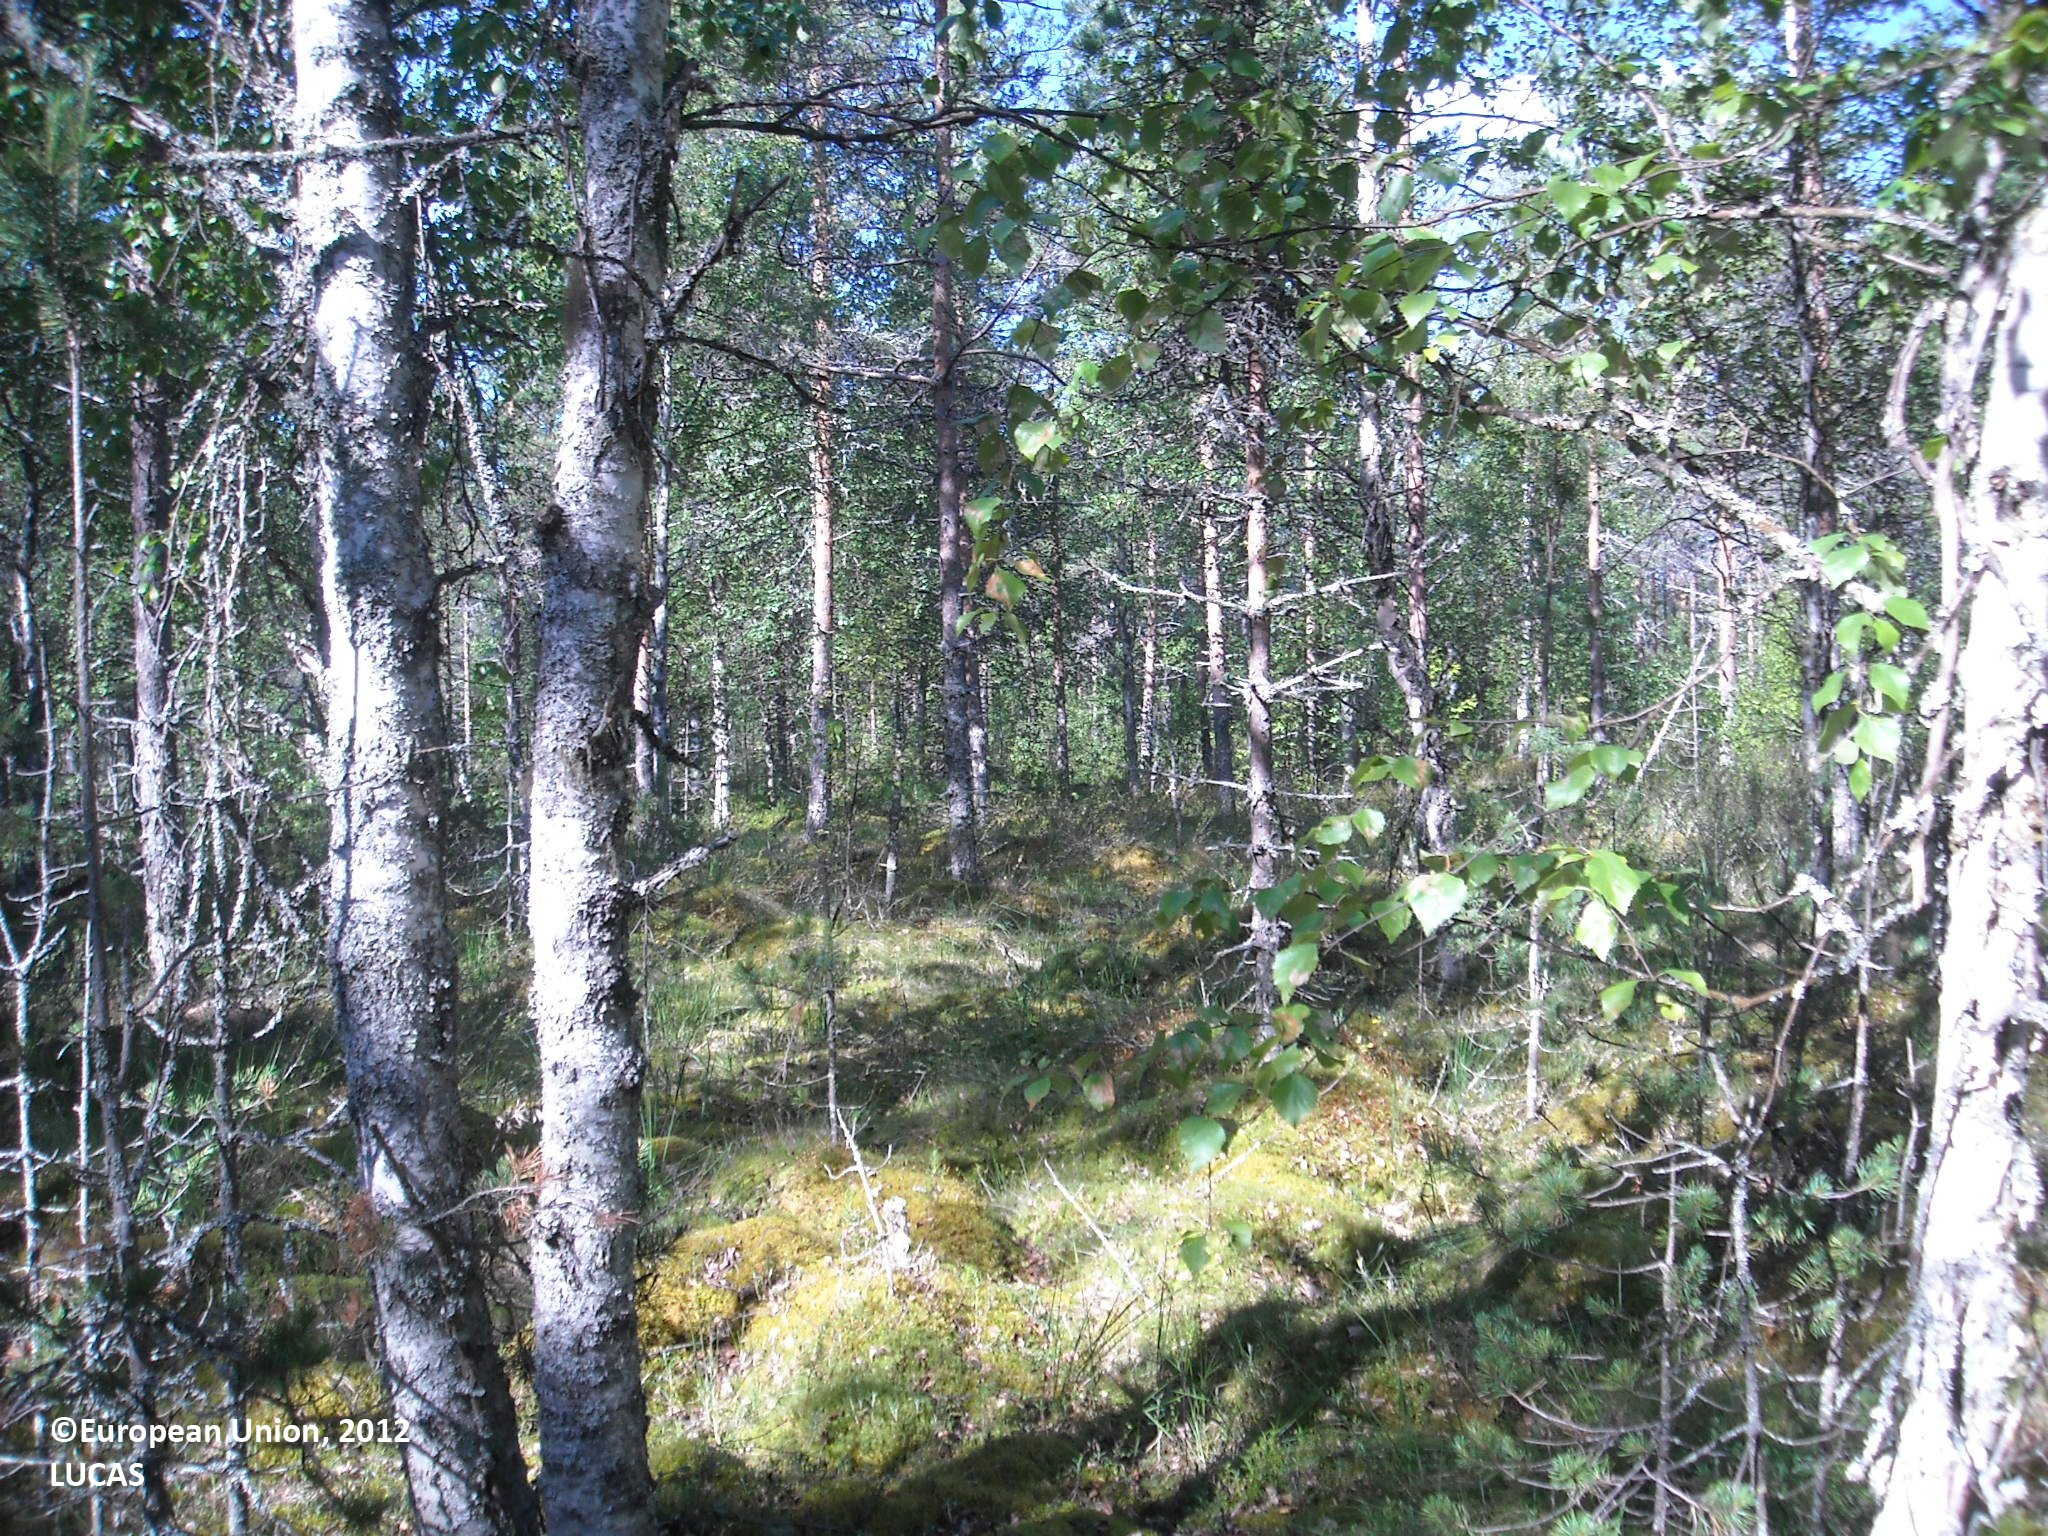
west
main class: Woodland
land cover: Pine dominated mixed woodland
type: mire and swamp forests
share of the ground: > 75 %
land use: Forestry
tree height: > 5 m
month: July
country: FI
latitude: 65.0695
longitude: 27.5066
